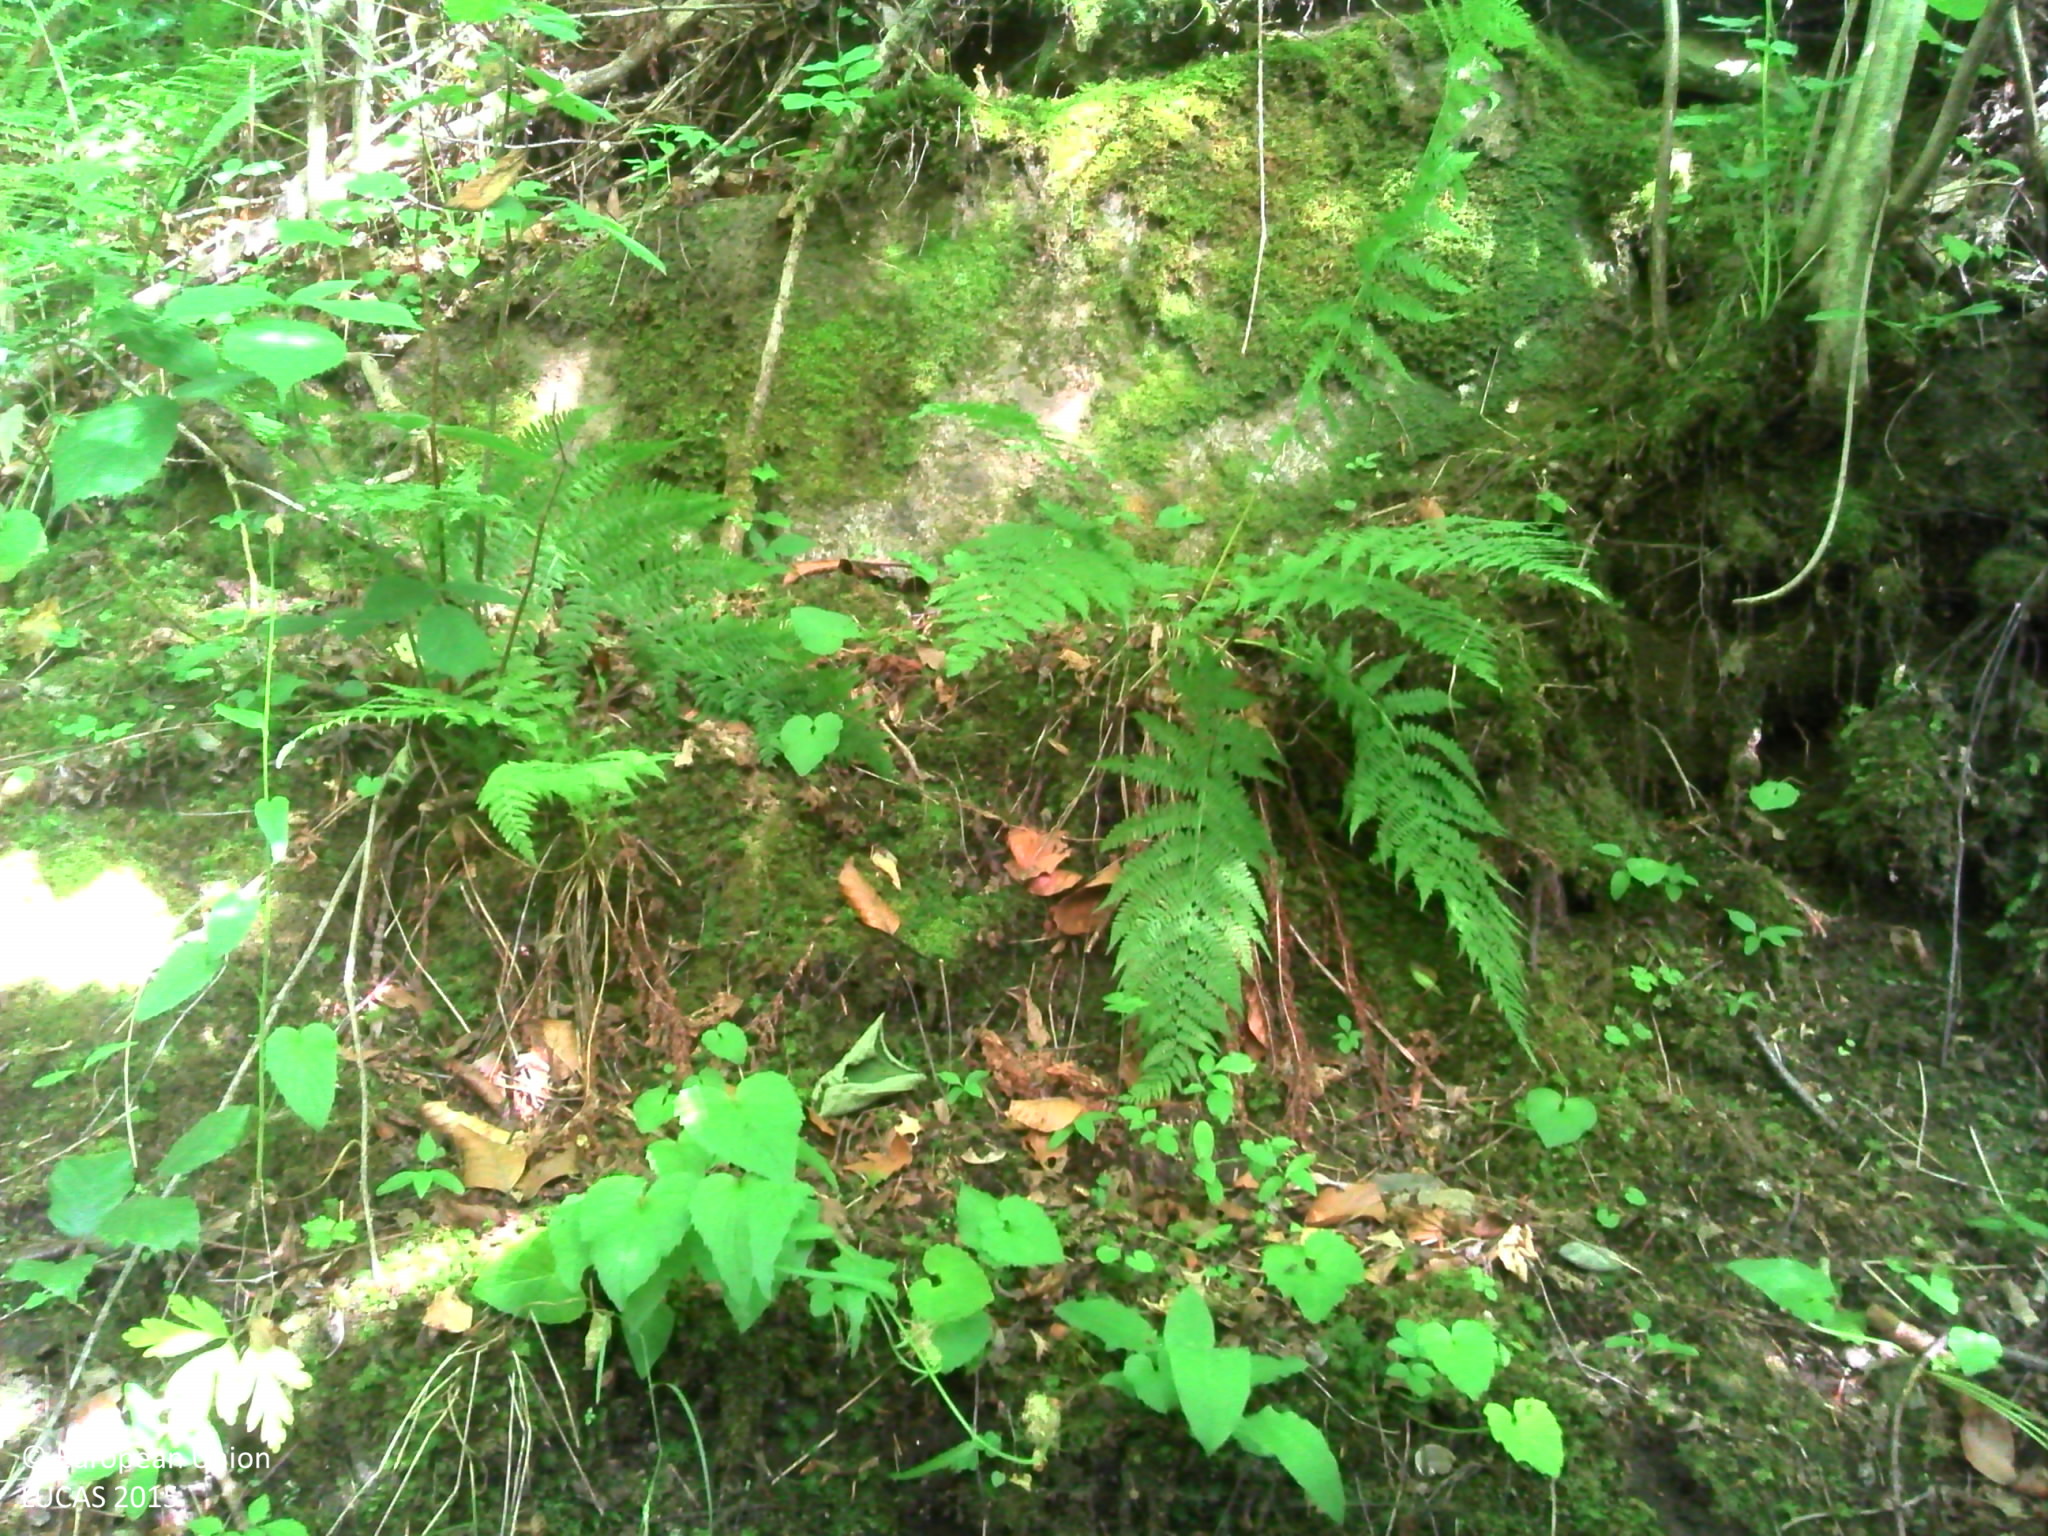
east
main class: Woodland
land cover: Broadleaved woodland
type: beech forest
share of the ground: > 75 %
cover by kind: broadleaved forest trees 85 %, herbaceous plants 10 %, coniferous forest trees 5 %
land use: Forestry
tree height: > 5 m
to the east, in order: Broadleaved woodland; Shrubland with sparse tree cover; Lines of trees; Ditches and canals; Paved roads, cycling and walking lanes; Electric lines; Broadleaved woodland; Tracks; Electric lines; Broadleaved woodland
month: June
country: FR
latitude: 44.4251
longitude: 3.9142
